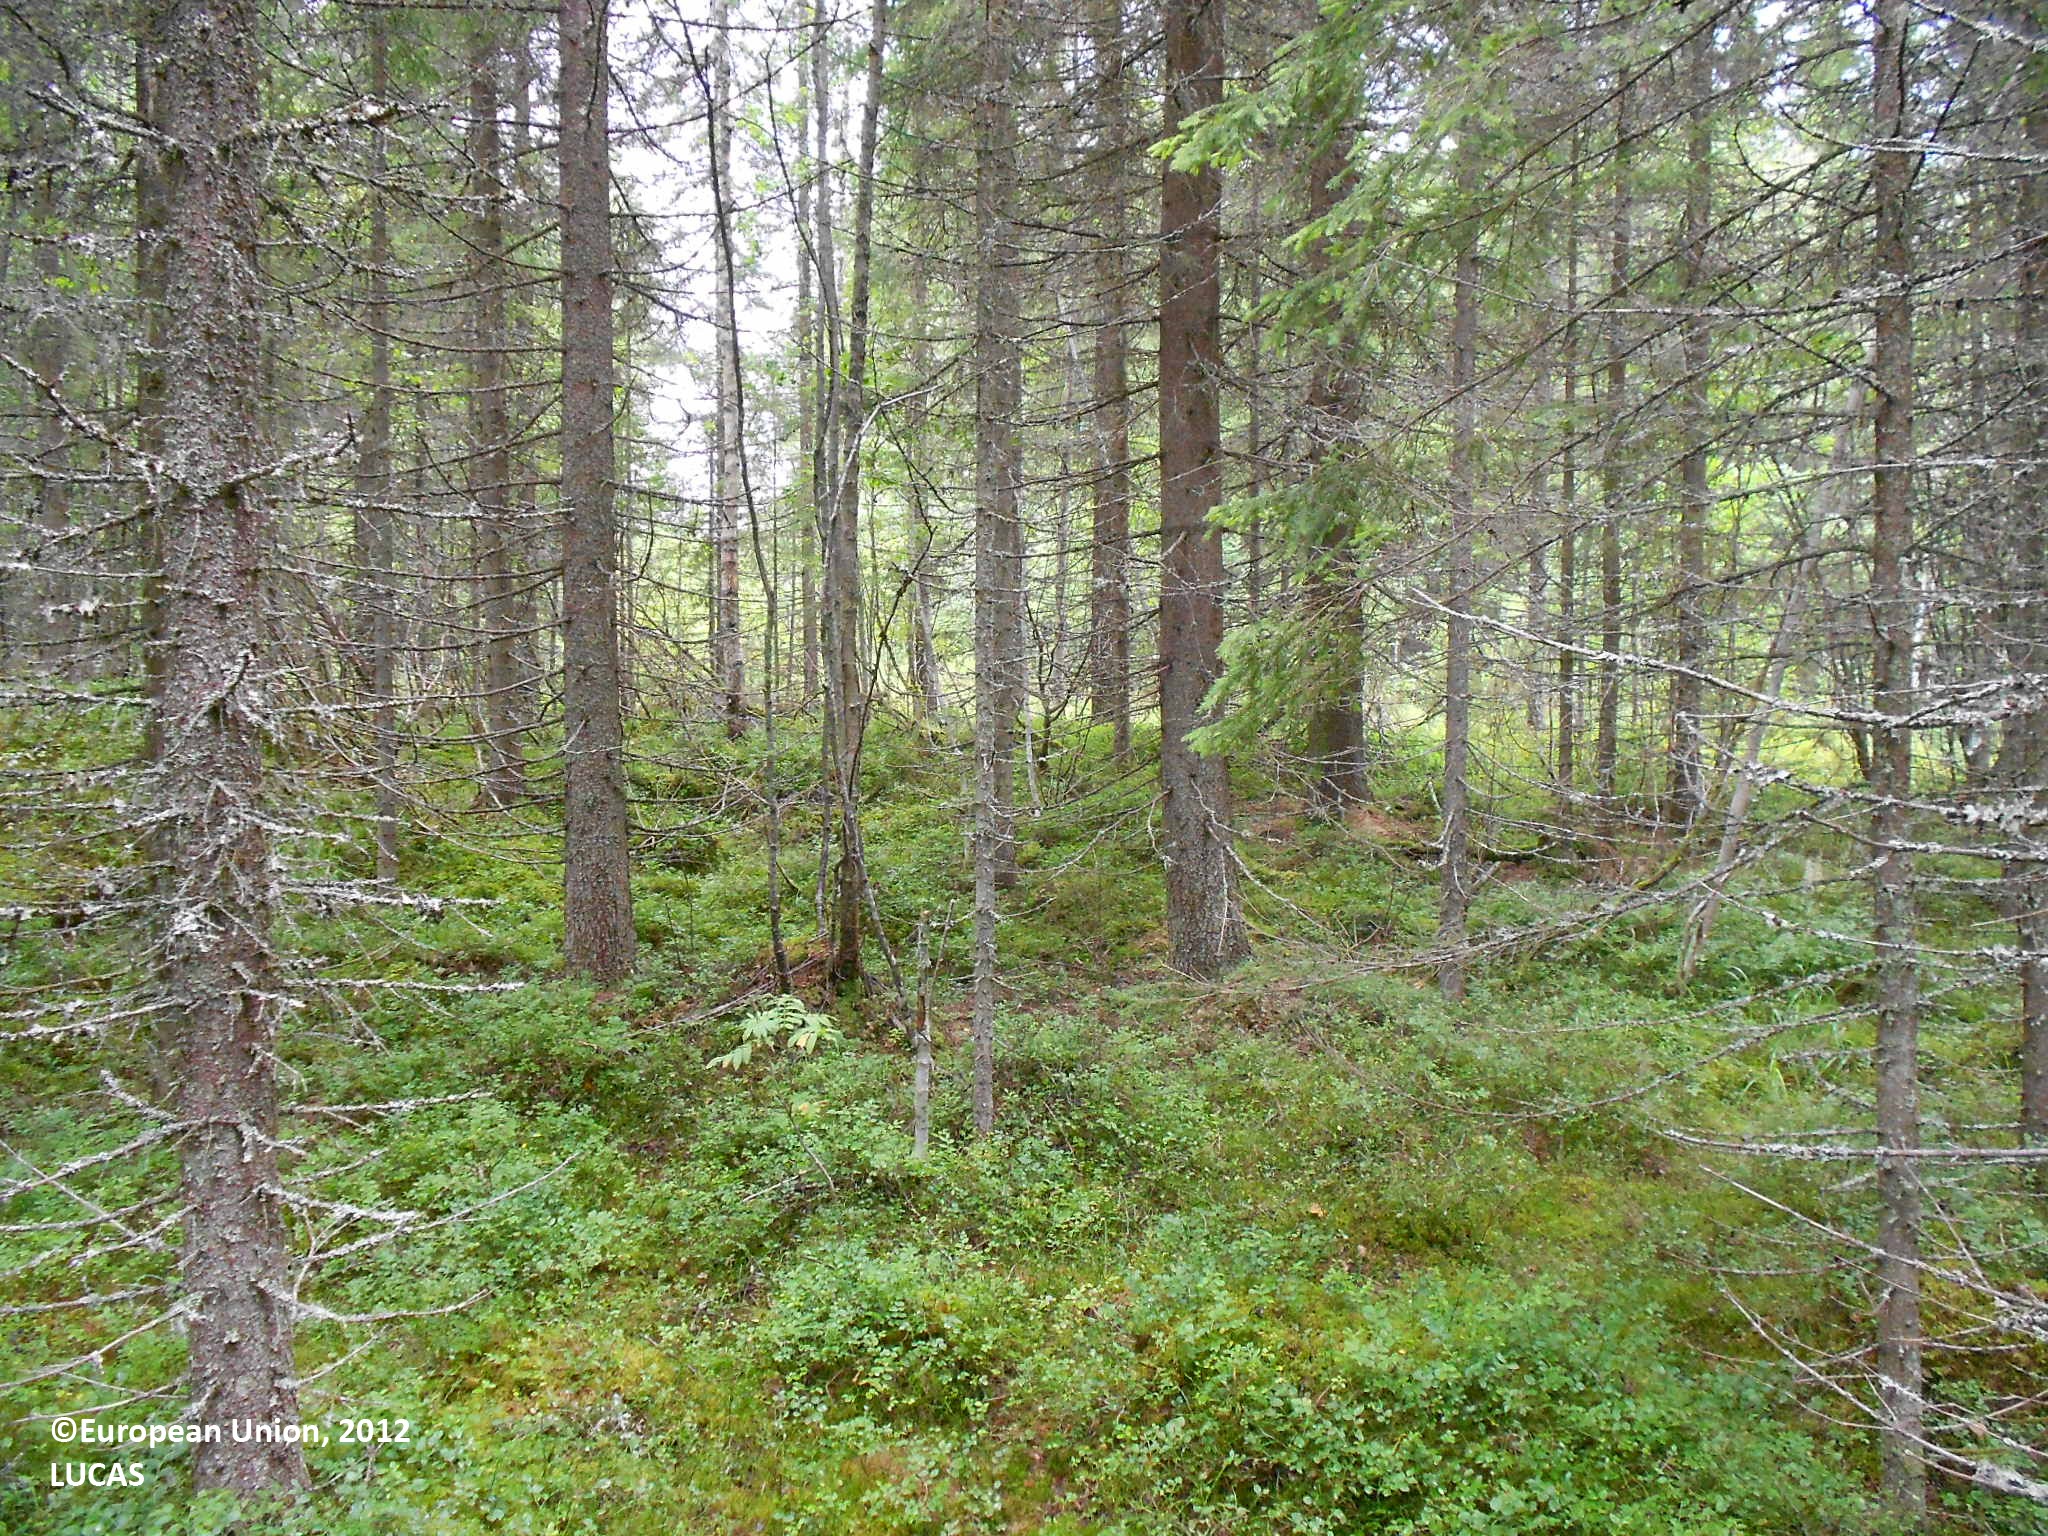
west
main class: Woodland
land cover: Spruce dominated coniferous woodland
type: boreal forest
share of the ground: > 75 %
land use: Forestry
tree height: > 5 m
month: August
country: FI
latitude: 63.4656
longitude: 28.9247
